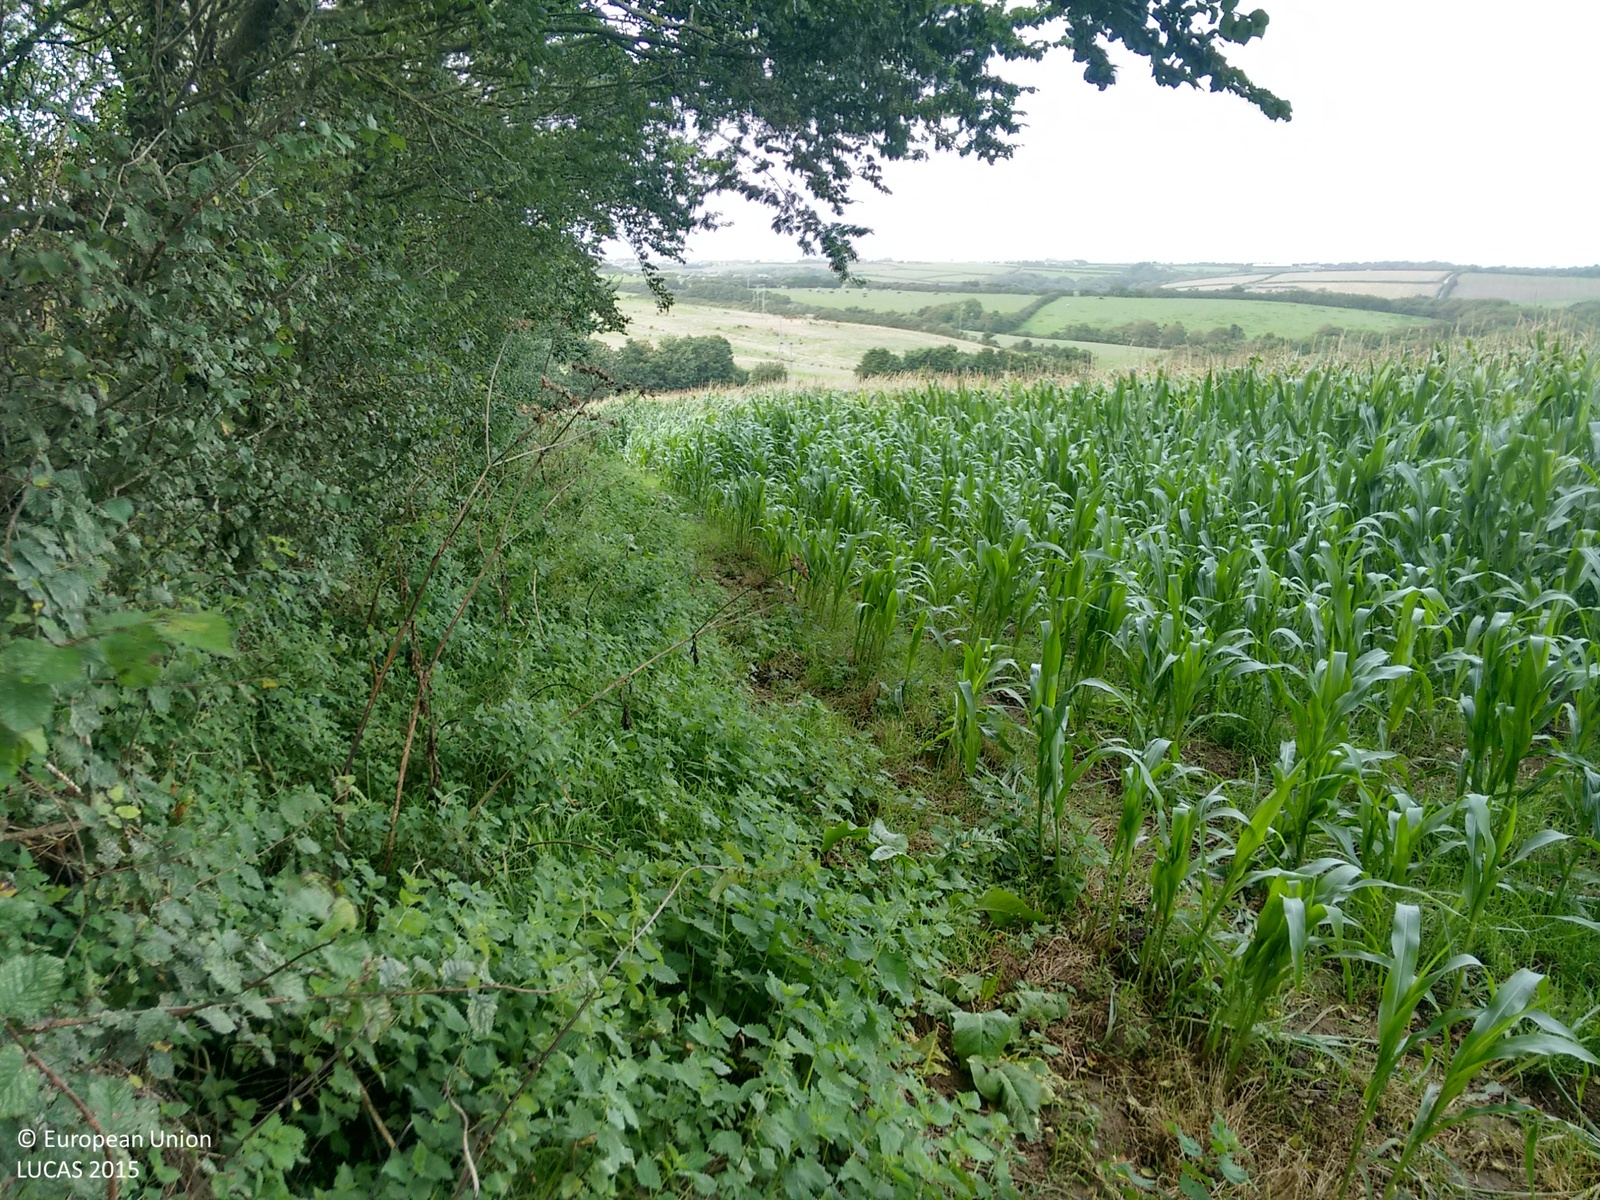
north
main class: Woodland
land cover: Broadleaved woodland
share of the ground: > 75 %
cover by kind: broadleaved forest trees 100 %
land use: Agriculture (excluding fallow land and kitchen gardens)
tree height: > 5 m
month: August
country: GB
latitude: 50.0304
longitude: -5.2395
